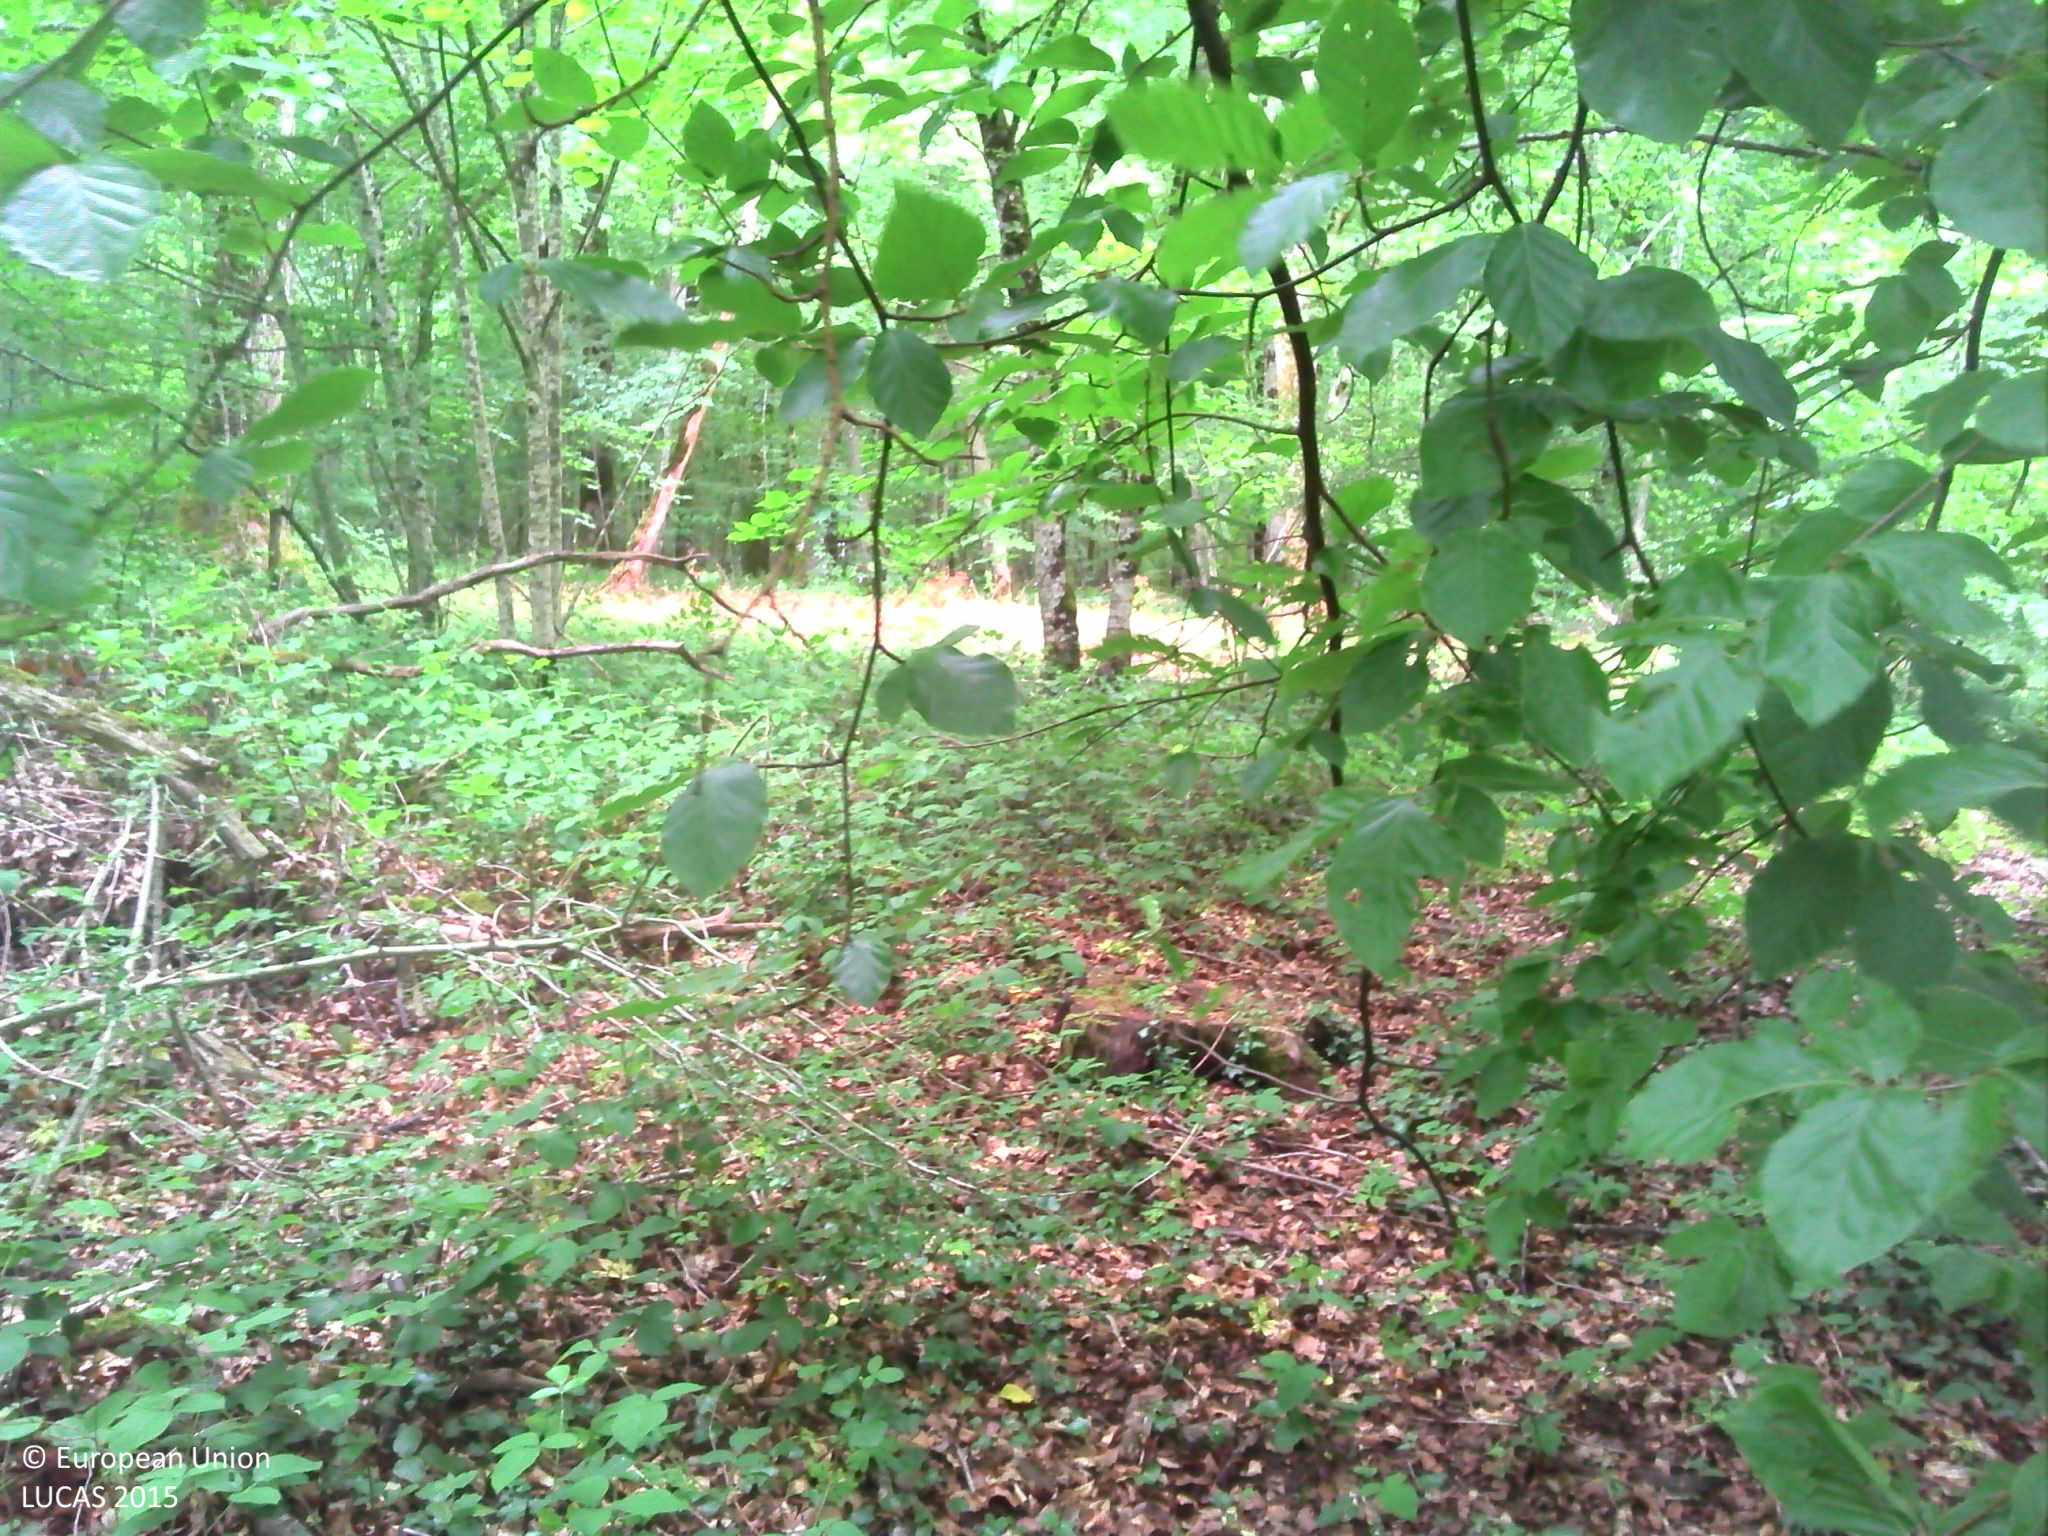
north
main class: Woodland
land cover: Broadleaved woodland
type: beech forest
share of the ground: > 75 %
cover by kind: broadleaved forest trees 90 %, herbaceous plants 10 %
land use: Forestry
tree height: > 5 m
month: June
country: FR
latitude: 48.3597
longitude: 4.9373
